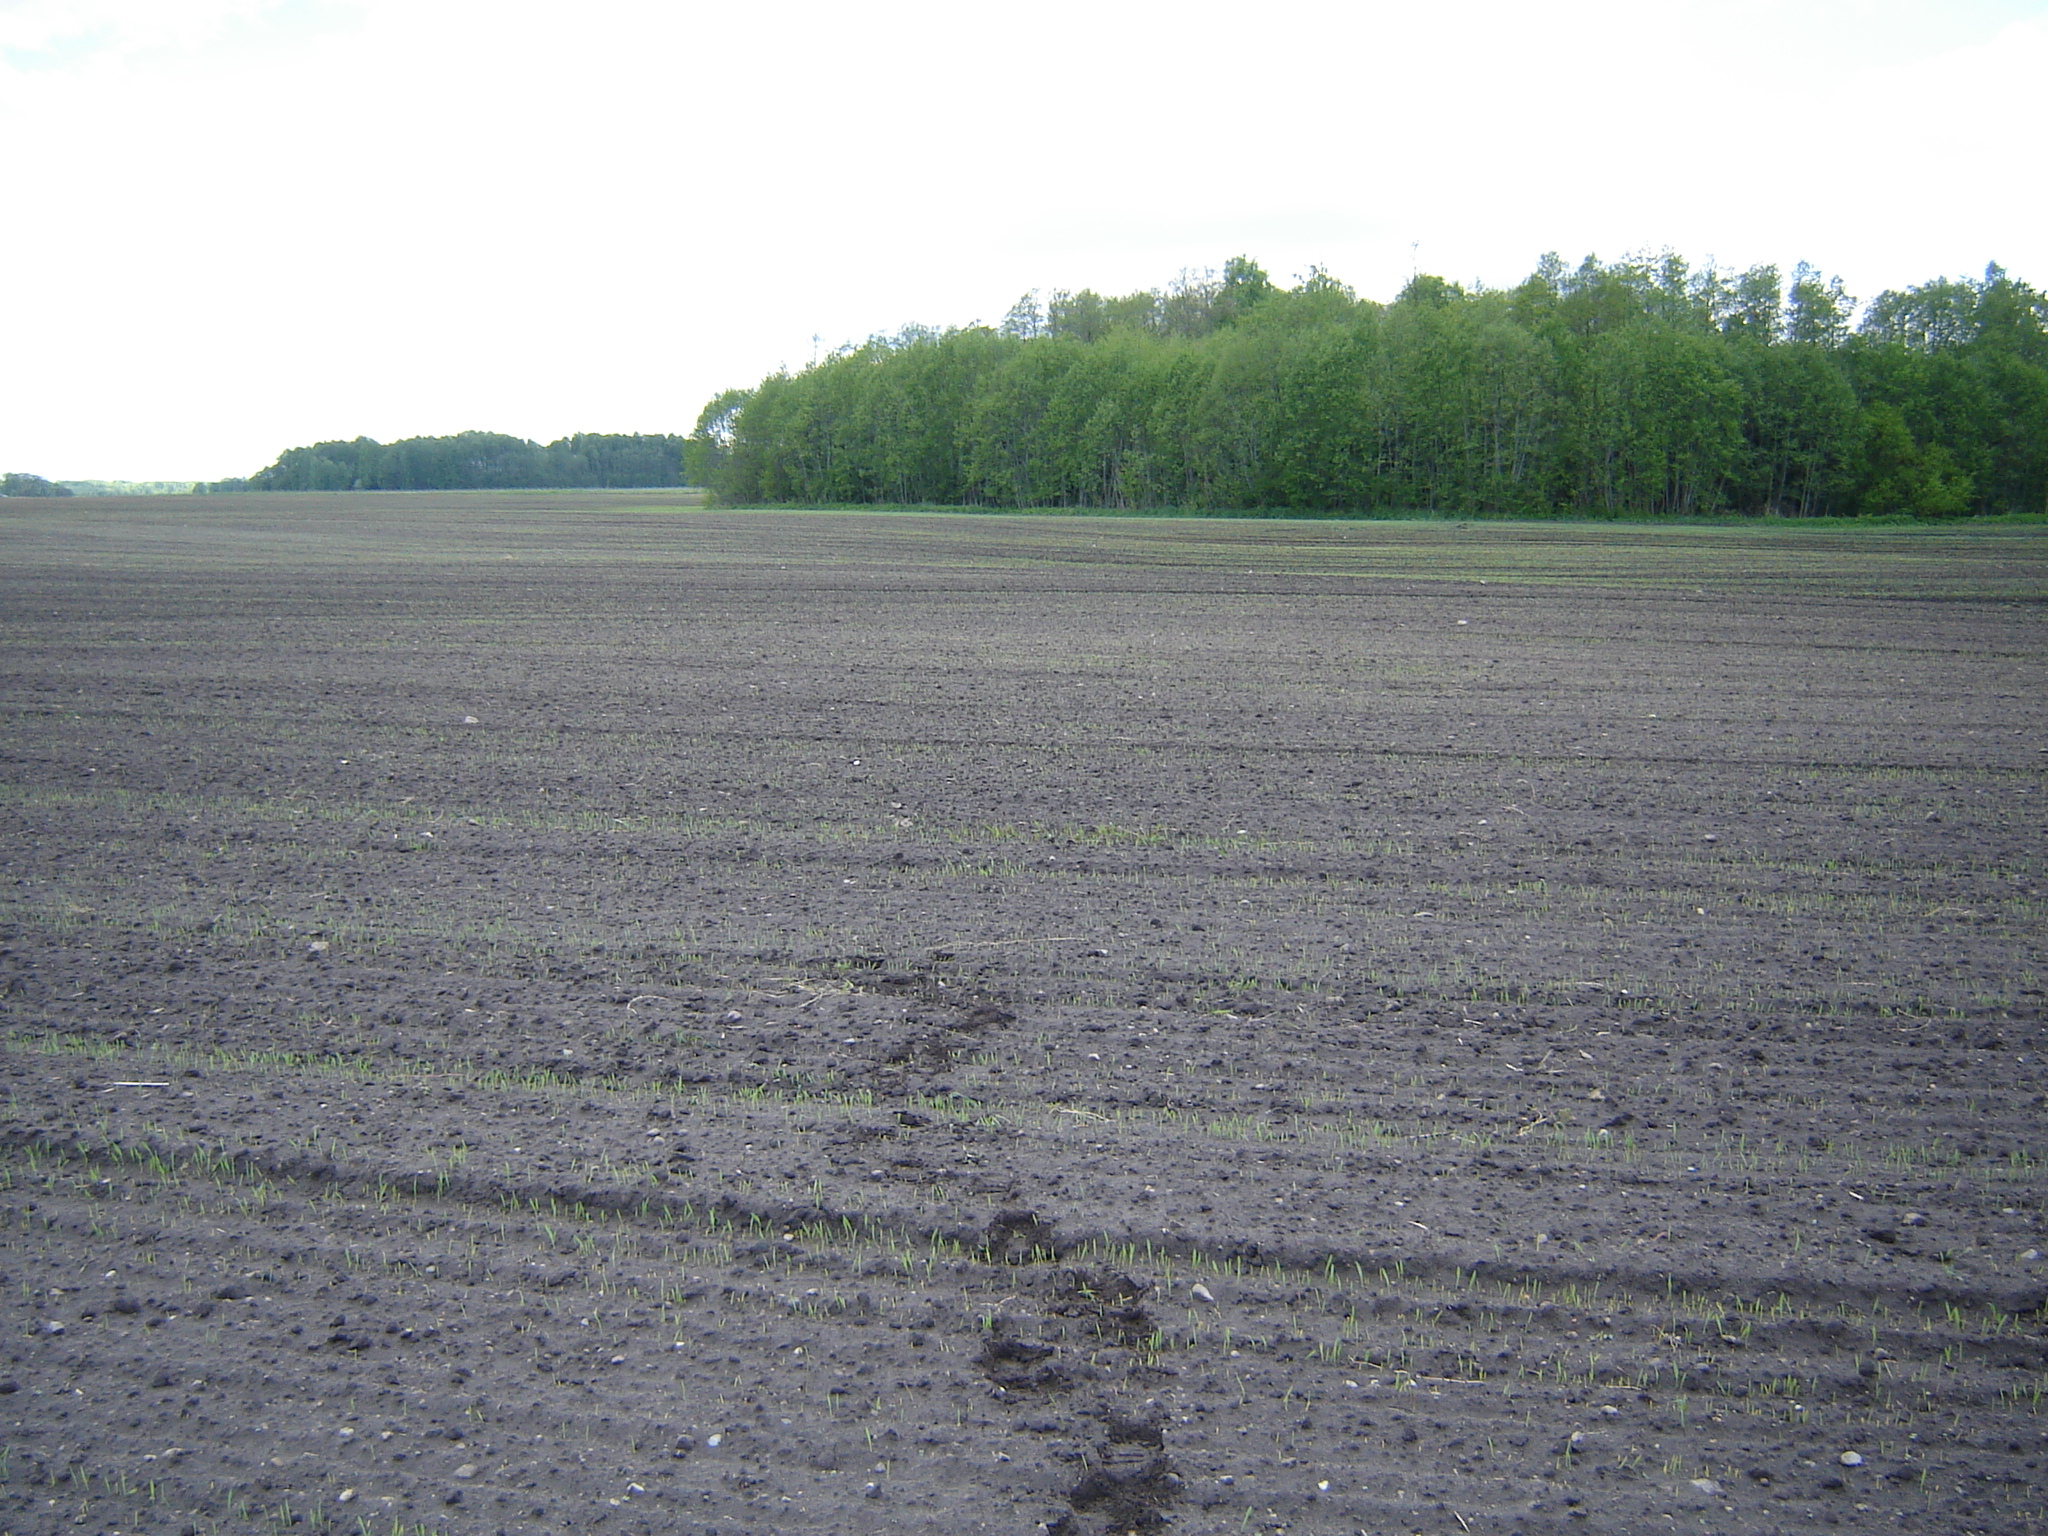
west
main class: Cropland
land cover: Barley
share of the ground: < 10 %
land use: Agriculture (excluding fallow land and kitchen gardens)
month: May
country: LT
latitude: 55.9897
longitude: 25.1995
